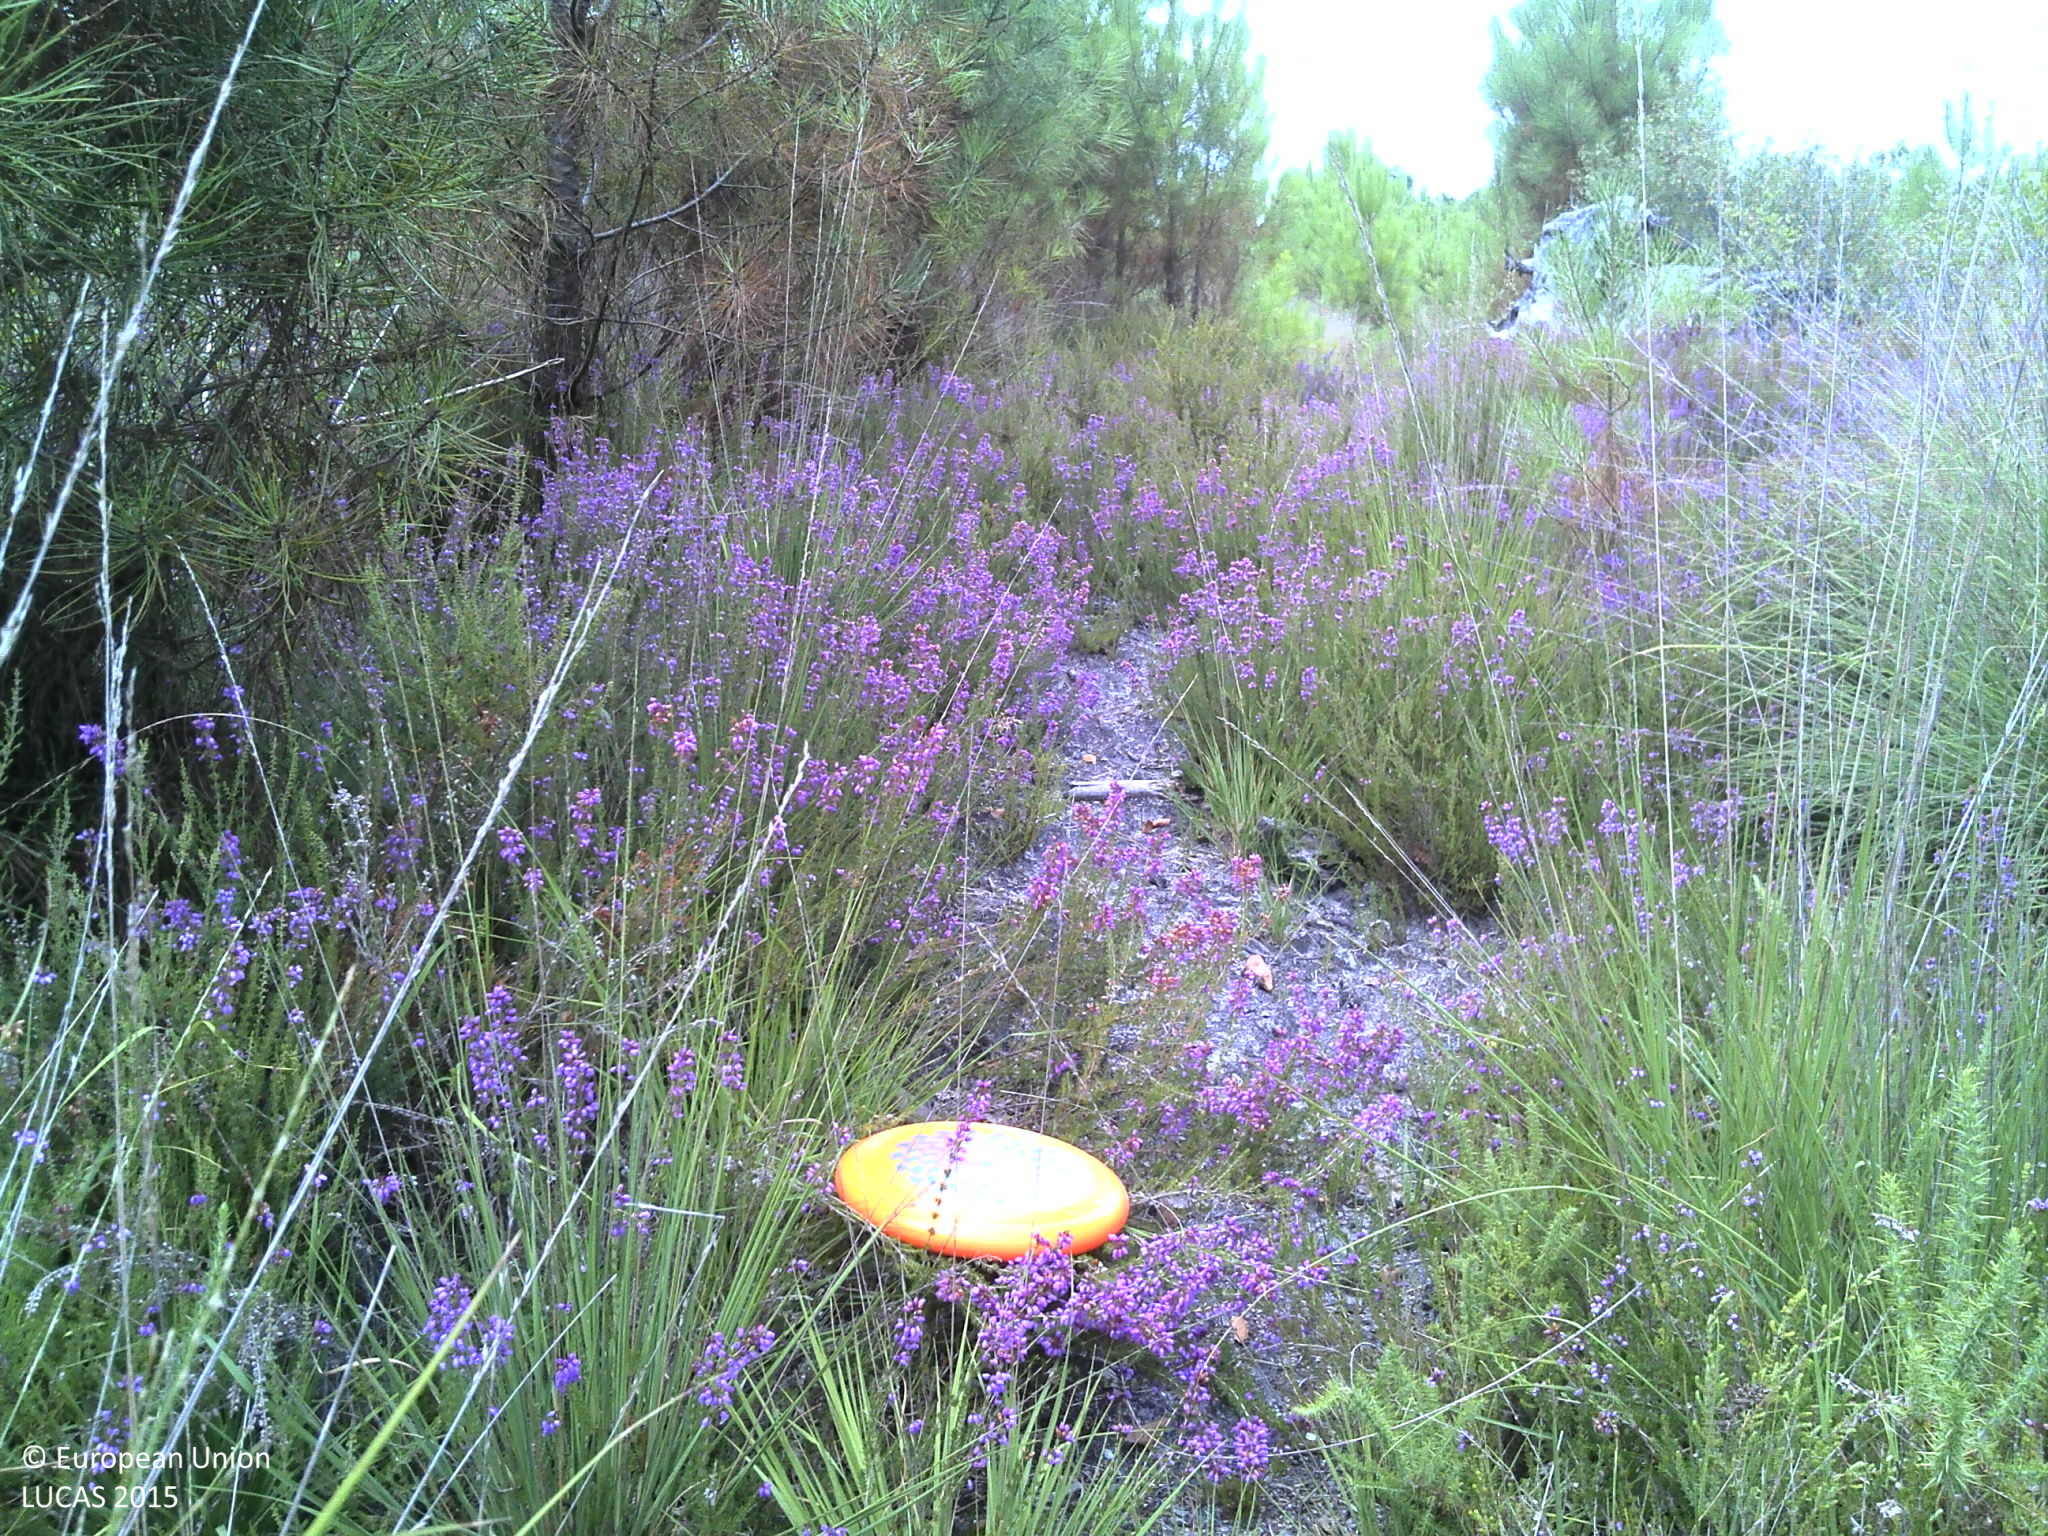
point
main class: Woodland
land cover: Pine dominated coniferous woodland
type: coniferous forest of the mediterranean region
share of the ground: 50 - 75 %
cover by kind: coniferous forest trees 60 %, shrubs 30 %, herbaceous plants 5 %, lichens and mosses 5 %
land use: Forestry
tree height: > 5 m
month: July
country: FR
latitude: 44.4948
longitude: -0.4406
